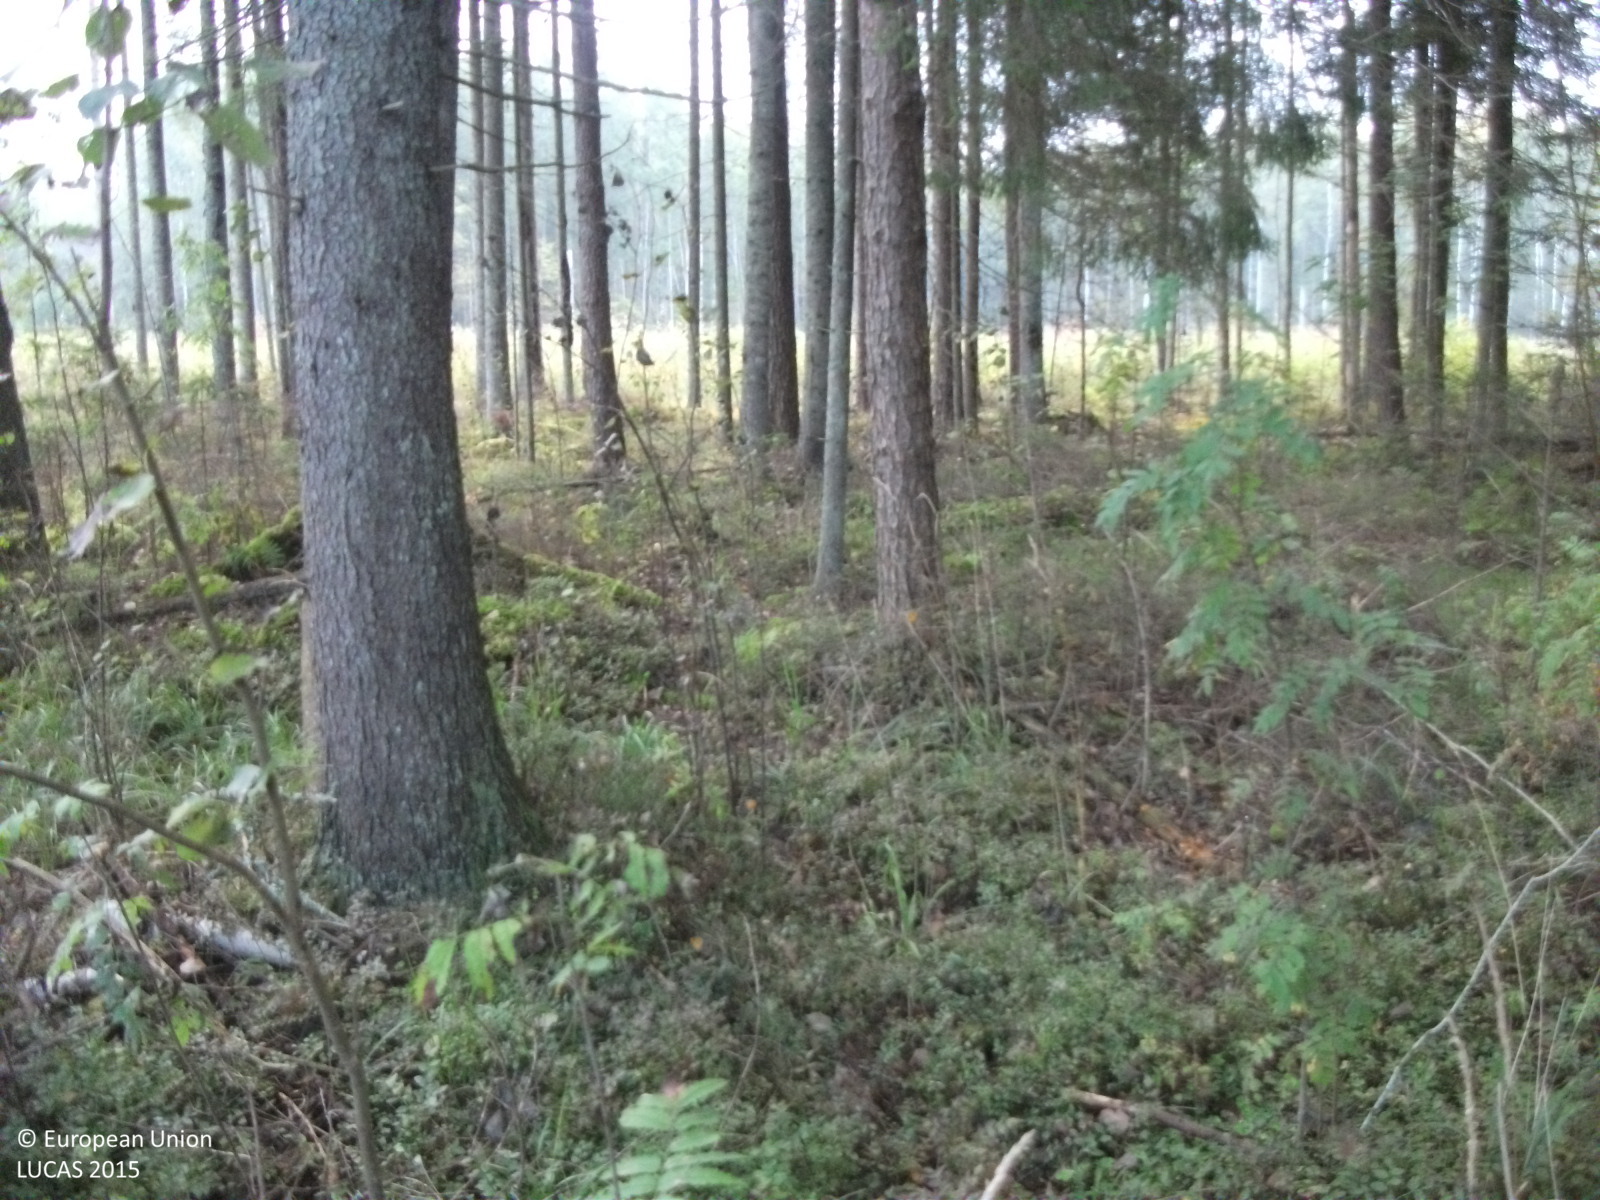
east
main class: Woodland
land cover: Spruce dominated coniferous woodland
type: hemiboreal forest and nemoral coniferous forest and mixed broadleaved-coniferous forest
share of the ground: > 75 %
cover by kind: coniferous forest trees 80 %, broadleaved forest trees 10 %, shrubs 5 %, herbaceous plants 5 %
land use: Forestry
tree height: > 5 m
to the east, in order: Spruce dominated coniferous woodland; Shrubland with sparse tree cover; Broadleaved woodland; Spruce dominated mixed woodland
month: September
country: LV
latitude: 57.9018
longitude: 24.5156
